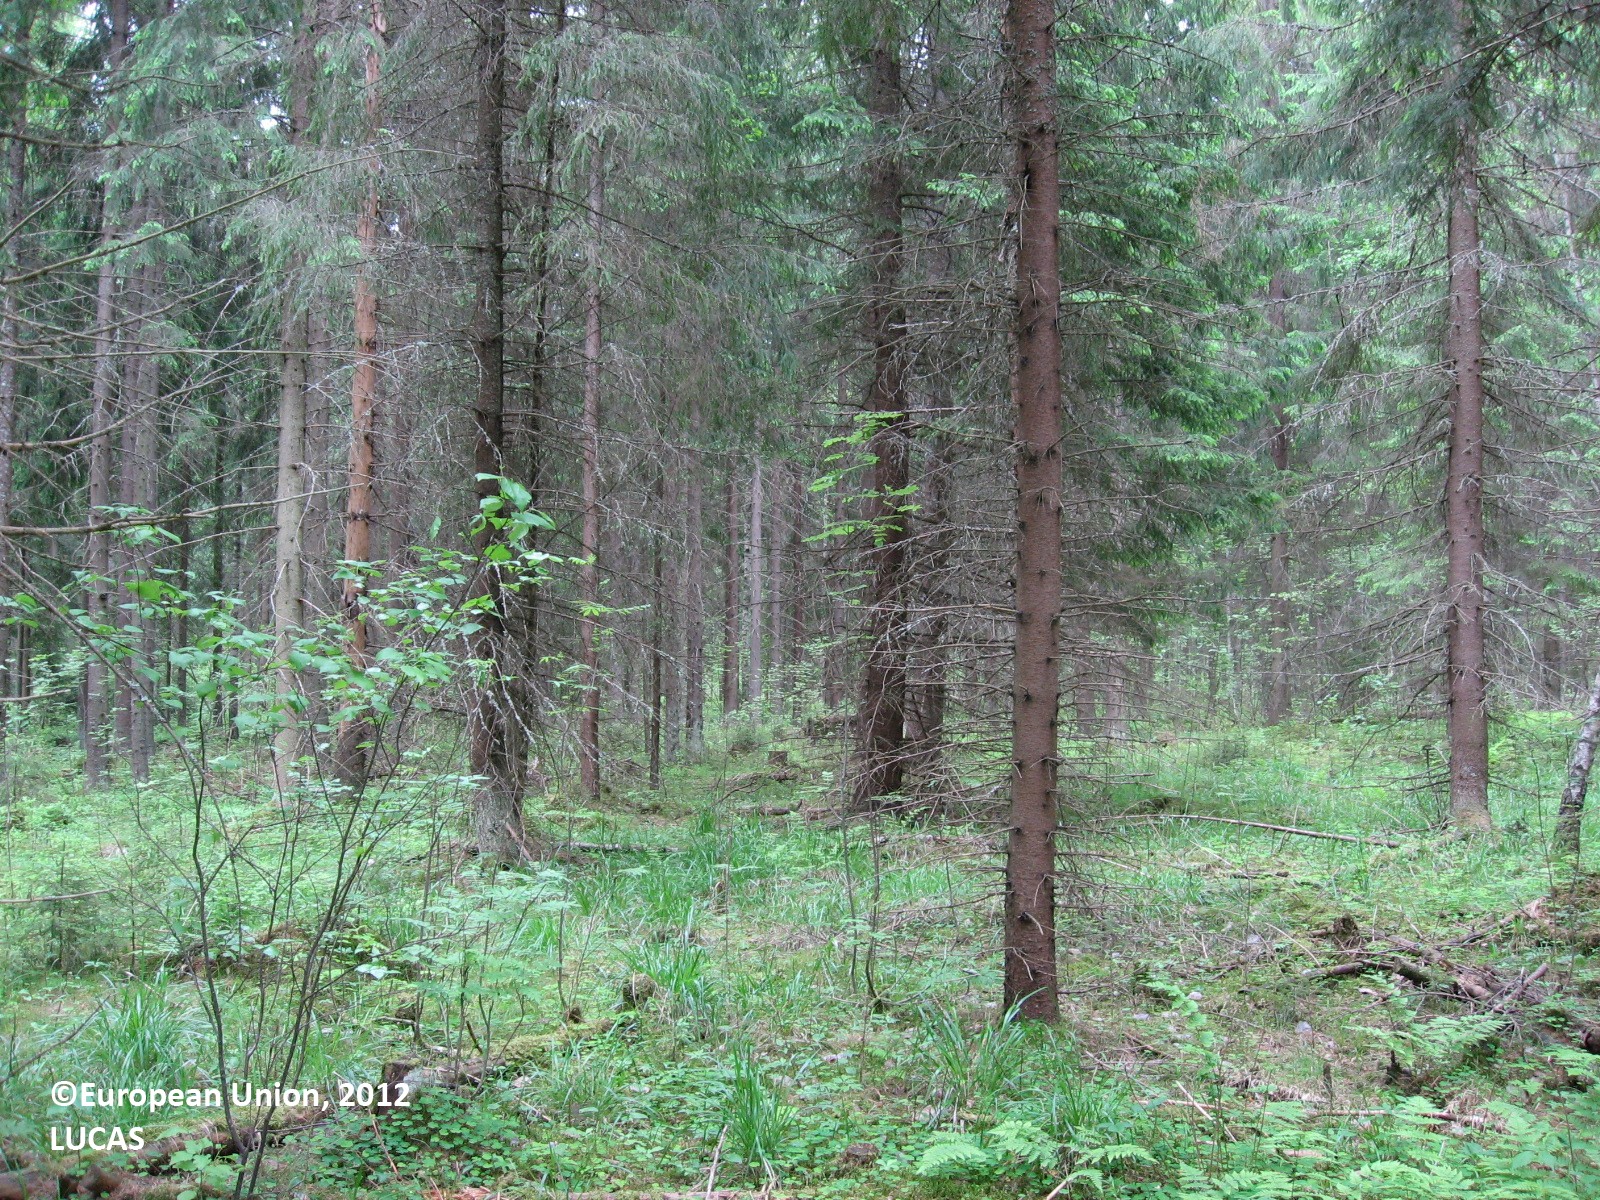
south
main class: Woodland
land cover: Spruce dominated mixed woodland
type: boreal forest
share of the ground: > 75 %
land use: Forestry
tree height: > 5 m
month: June
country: FI
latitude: 60.4415
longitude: 24.9642
